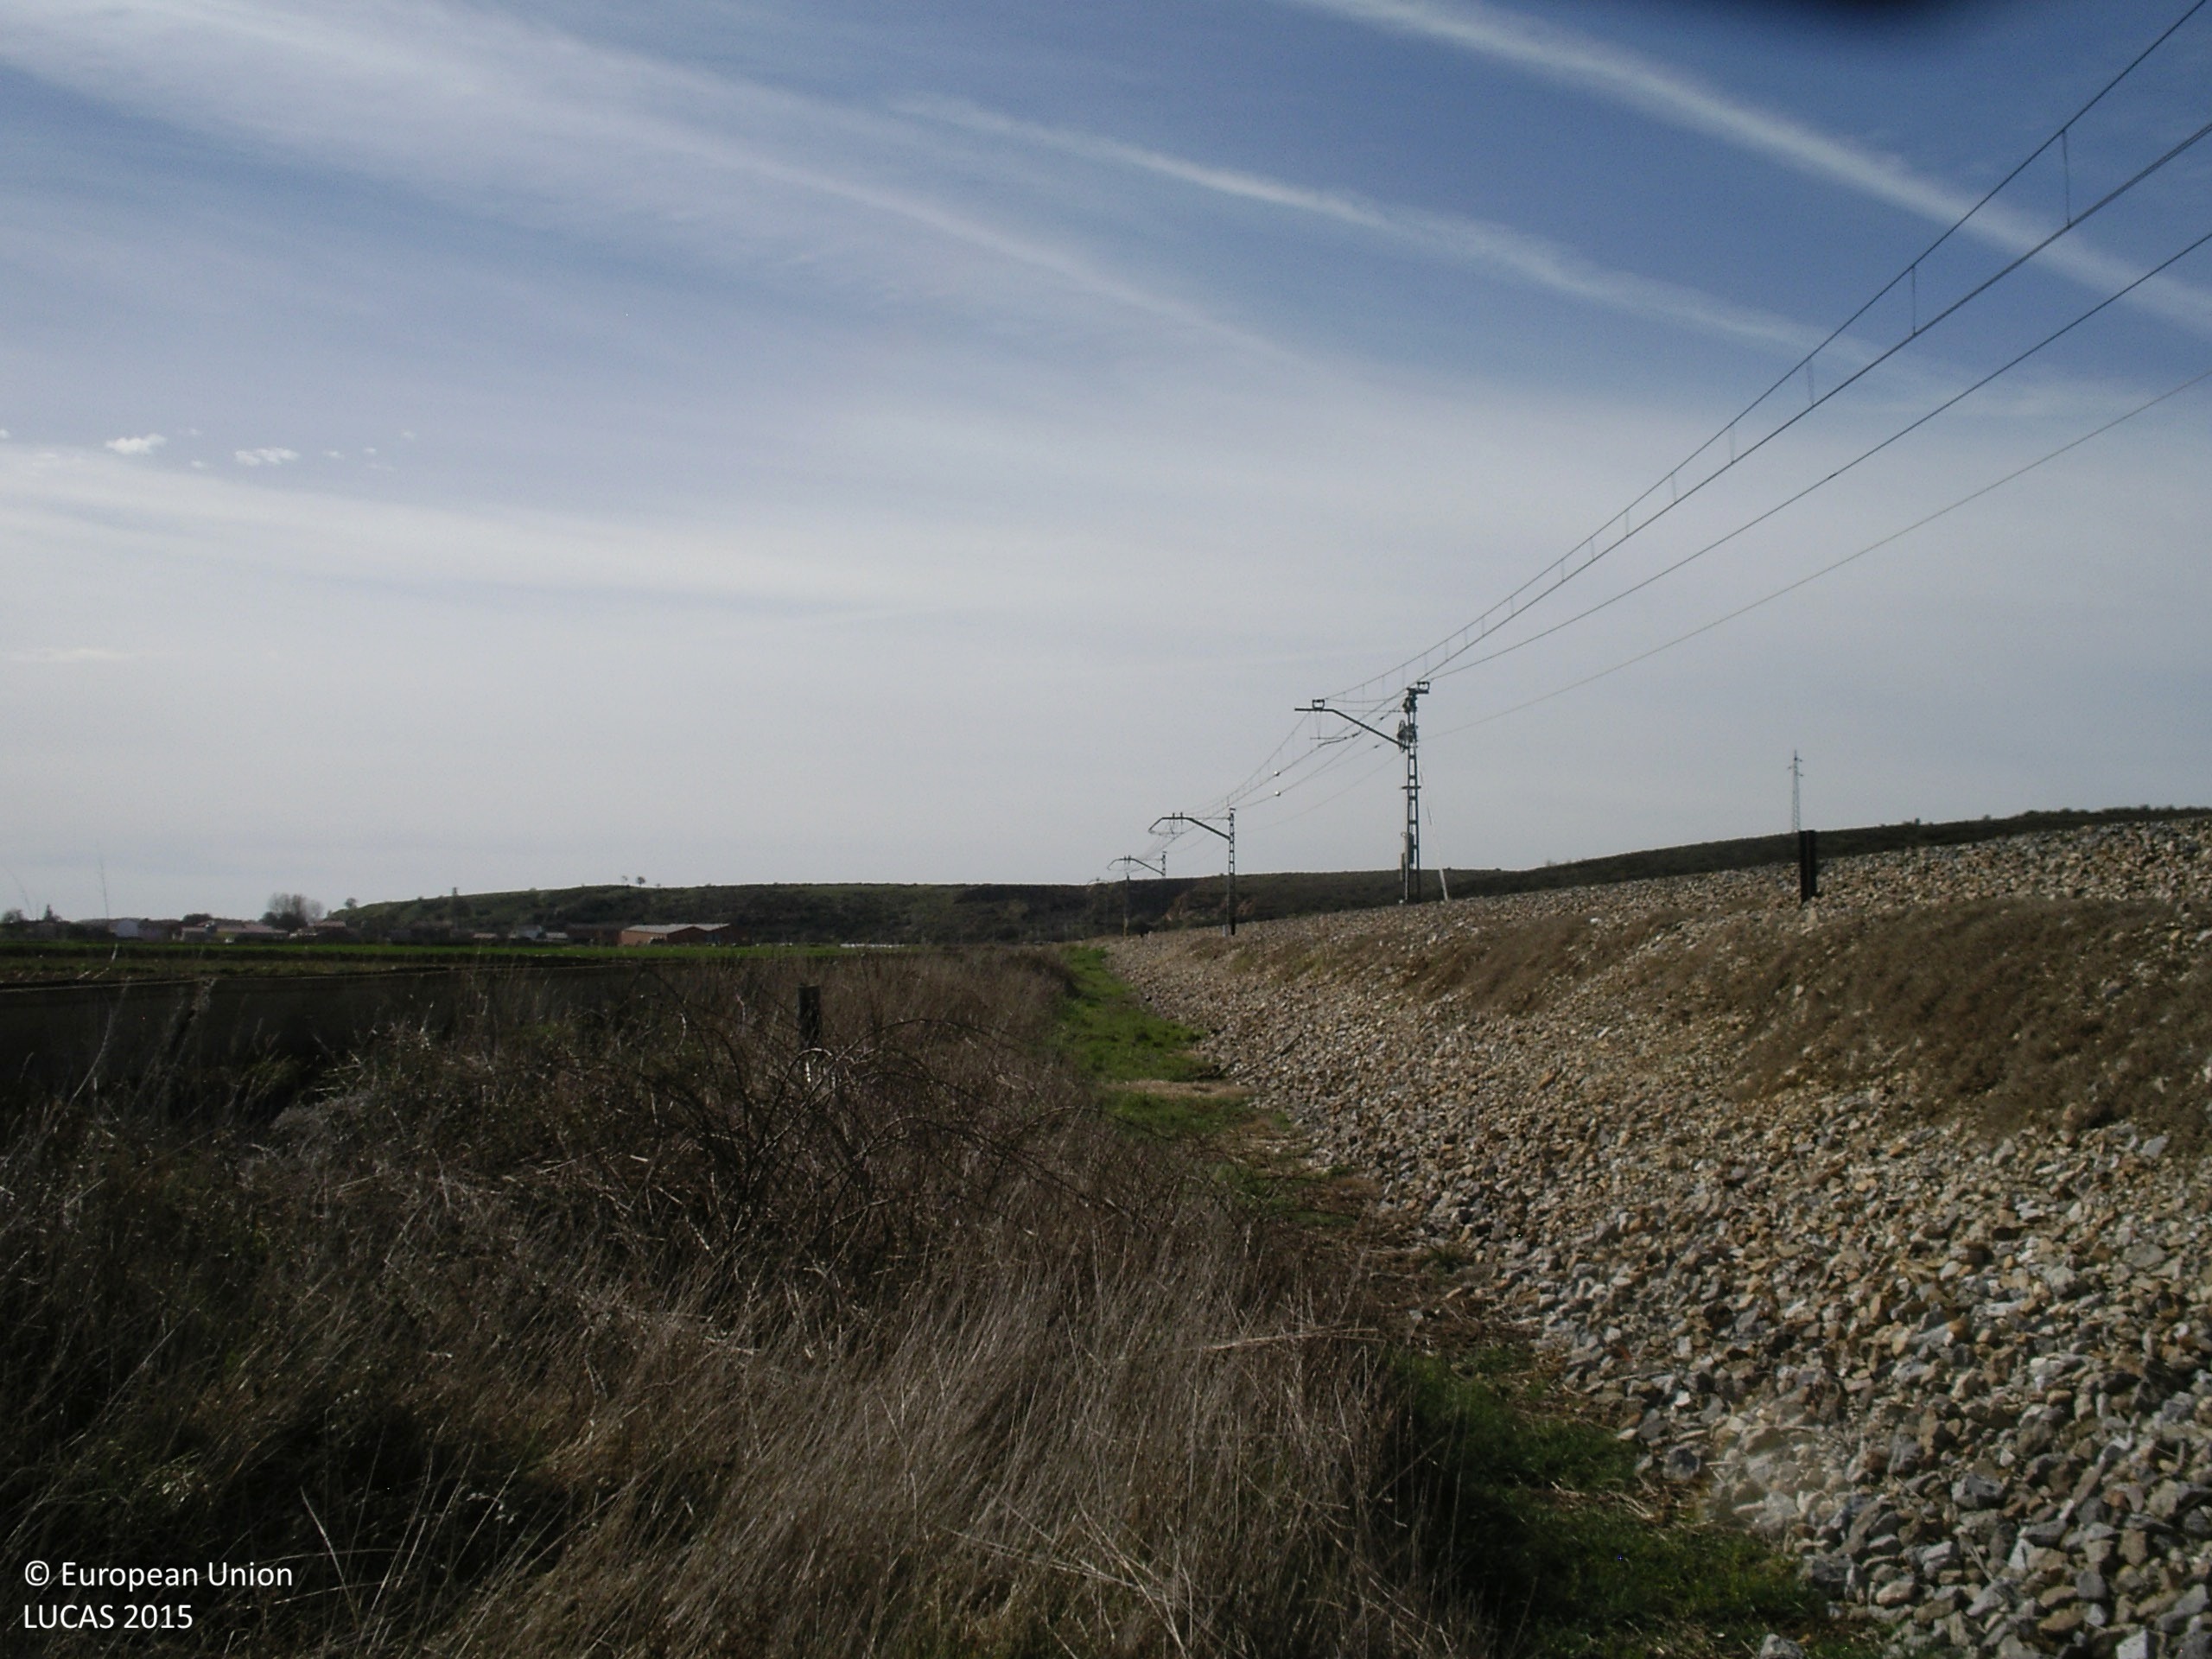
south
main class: Grassland
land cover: Grassland without tree/shrub cover
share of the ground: 10 - 25 %
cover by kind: herbaceous plants 50 %, unconsolidated bare surface 20 %
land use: Railway transport
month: April
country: ES
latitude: 42.4844
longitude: -6.0552
